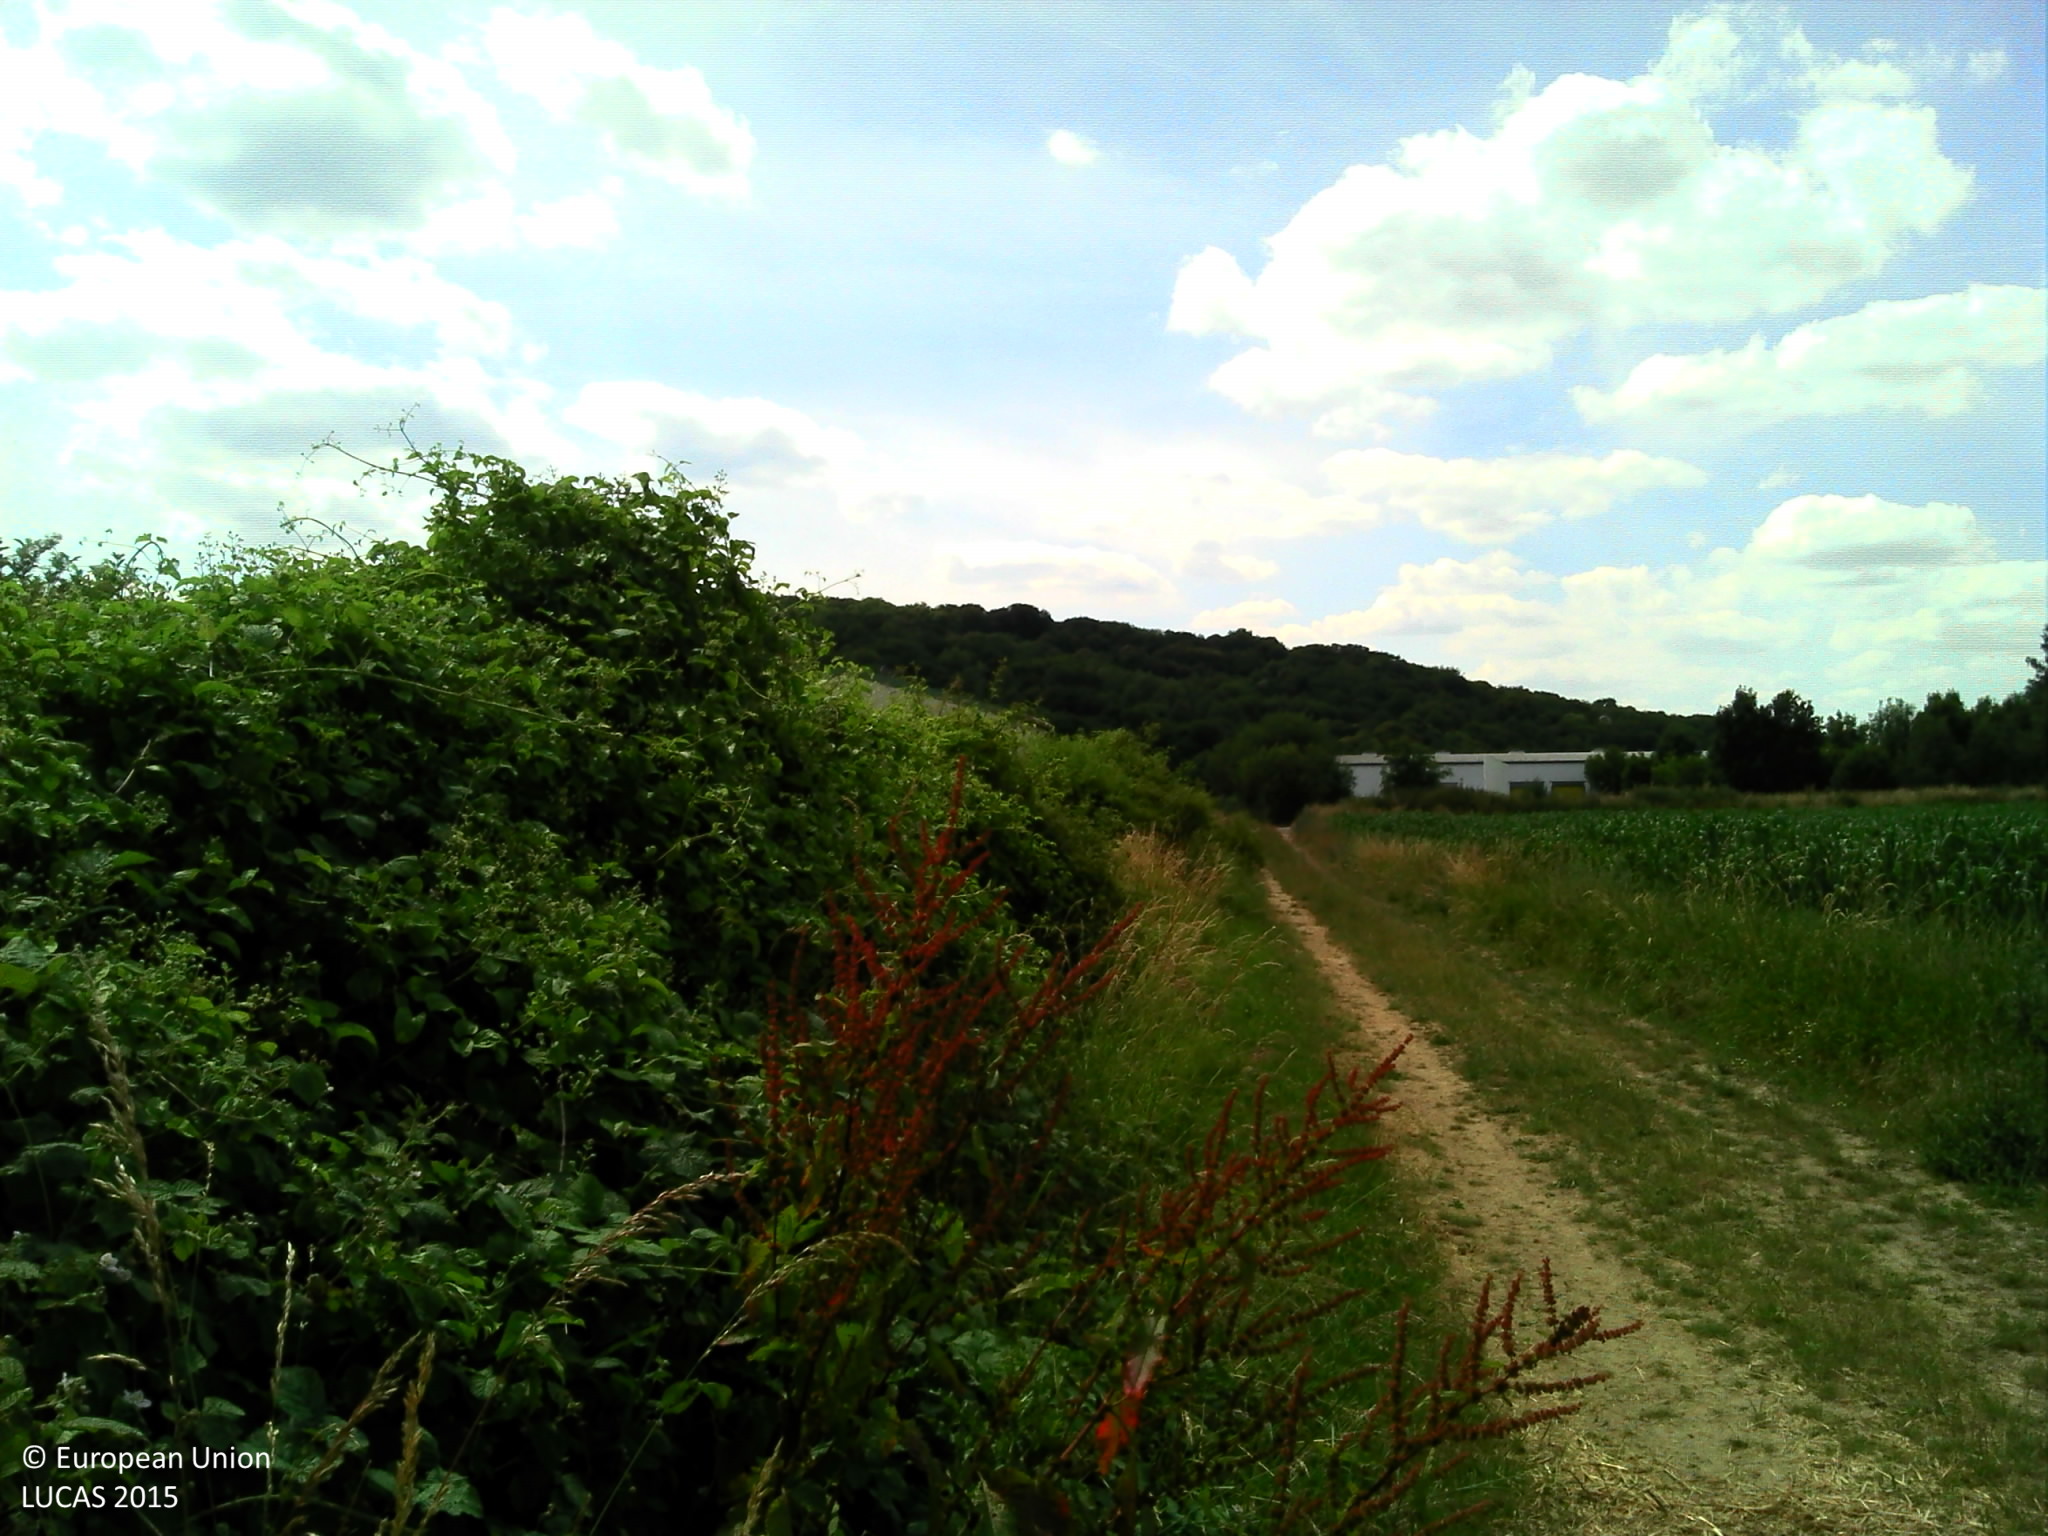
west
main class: Cropland
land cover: Maize
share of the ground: > 75 %
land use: Agriculture (excluding fallow land and kitchen gardens)
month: June
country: FR
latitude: 49.3617
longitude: 2.5393
